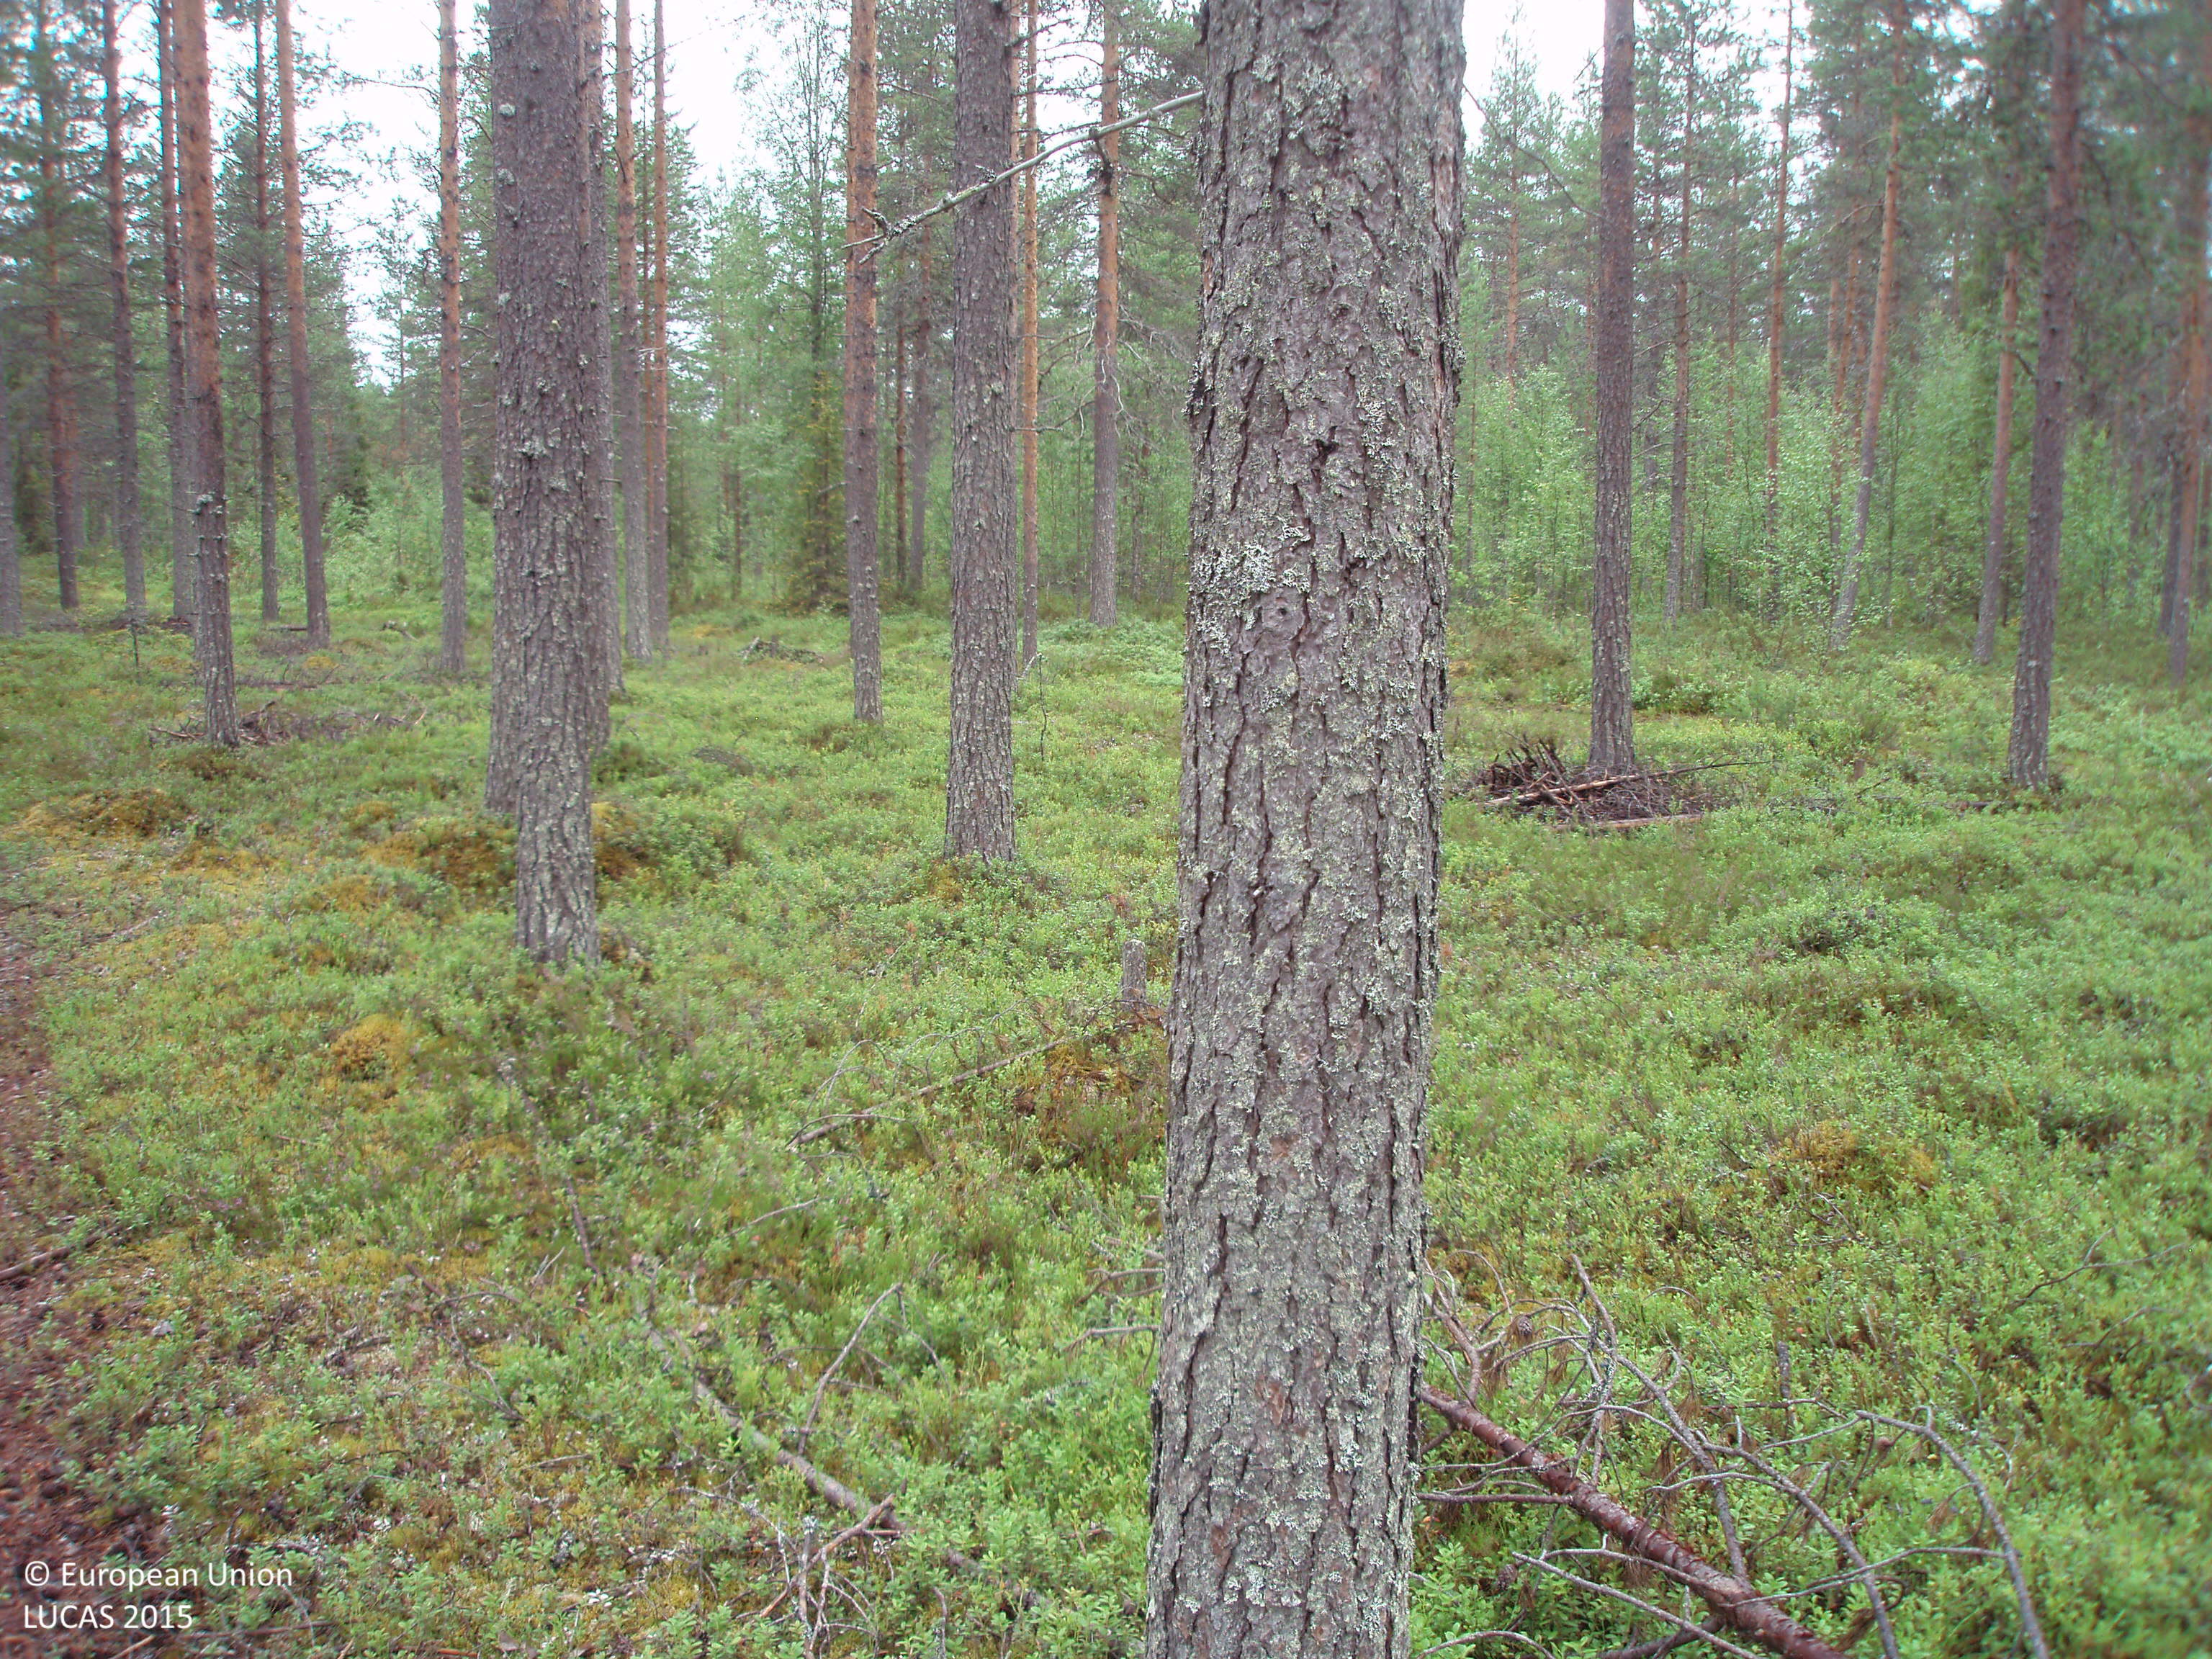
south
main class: Woodland
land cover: Pine dominated coniferous woodland
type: boreal forest
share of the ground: 50 - 75 %
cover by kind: coniferous forest trees 65 %, shrubs 35 %
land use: Forestry
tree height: > 5 m
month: August
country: FI
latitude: 65.6194
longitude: 27.0709
